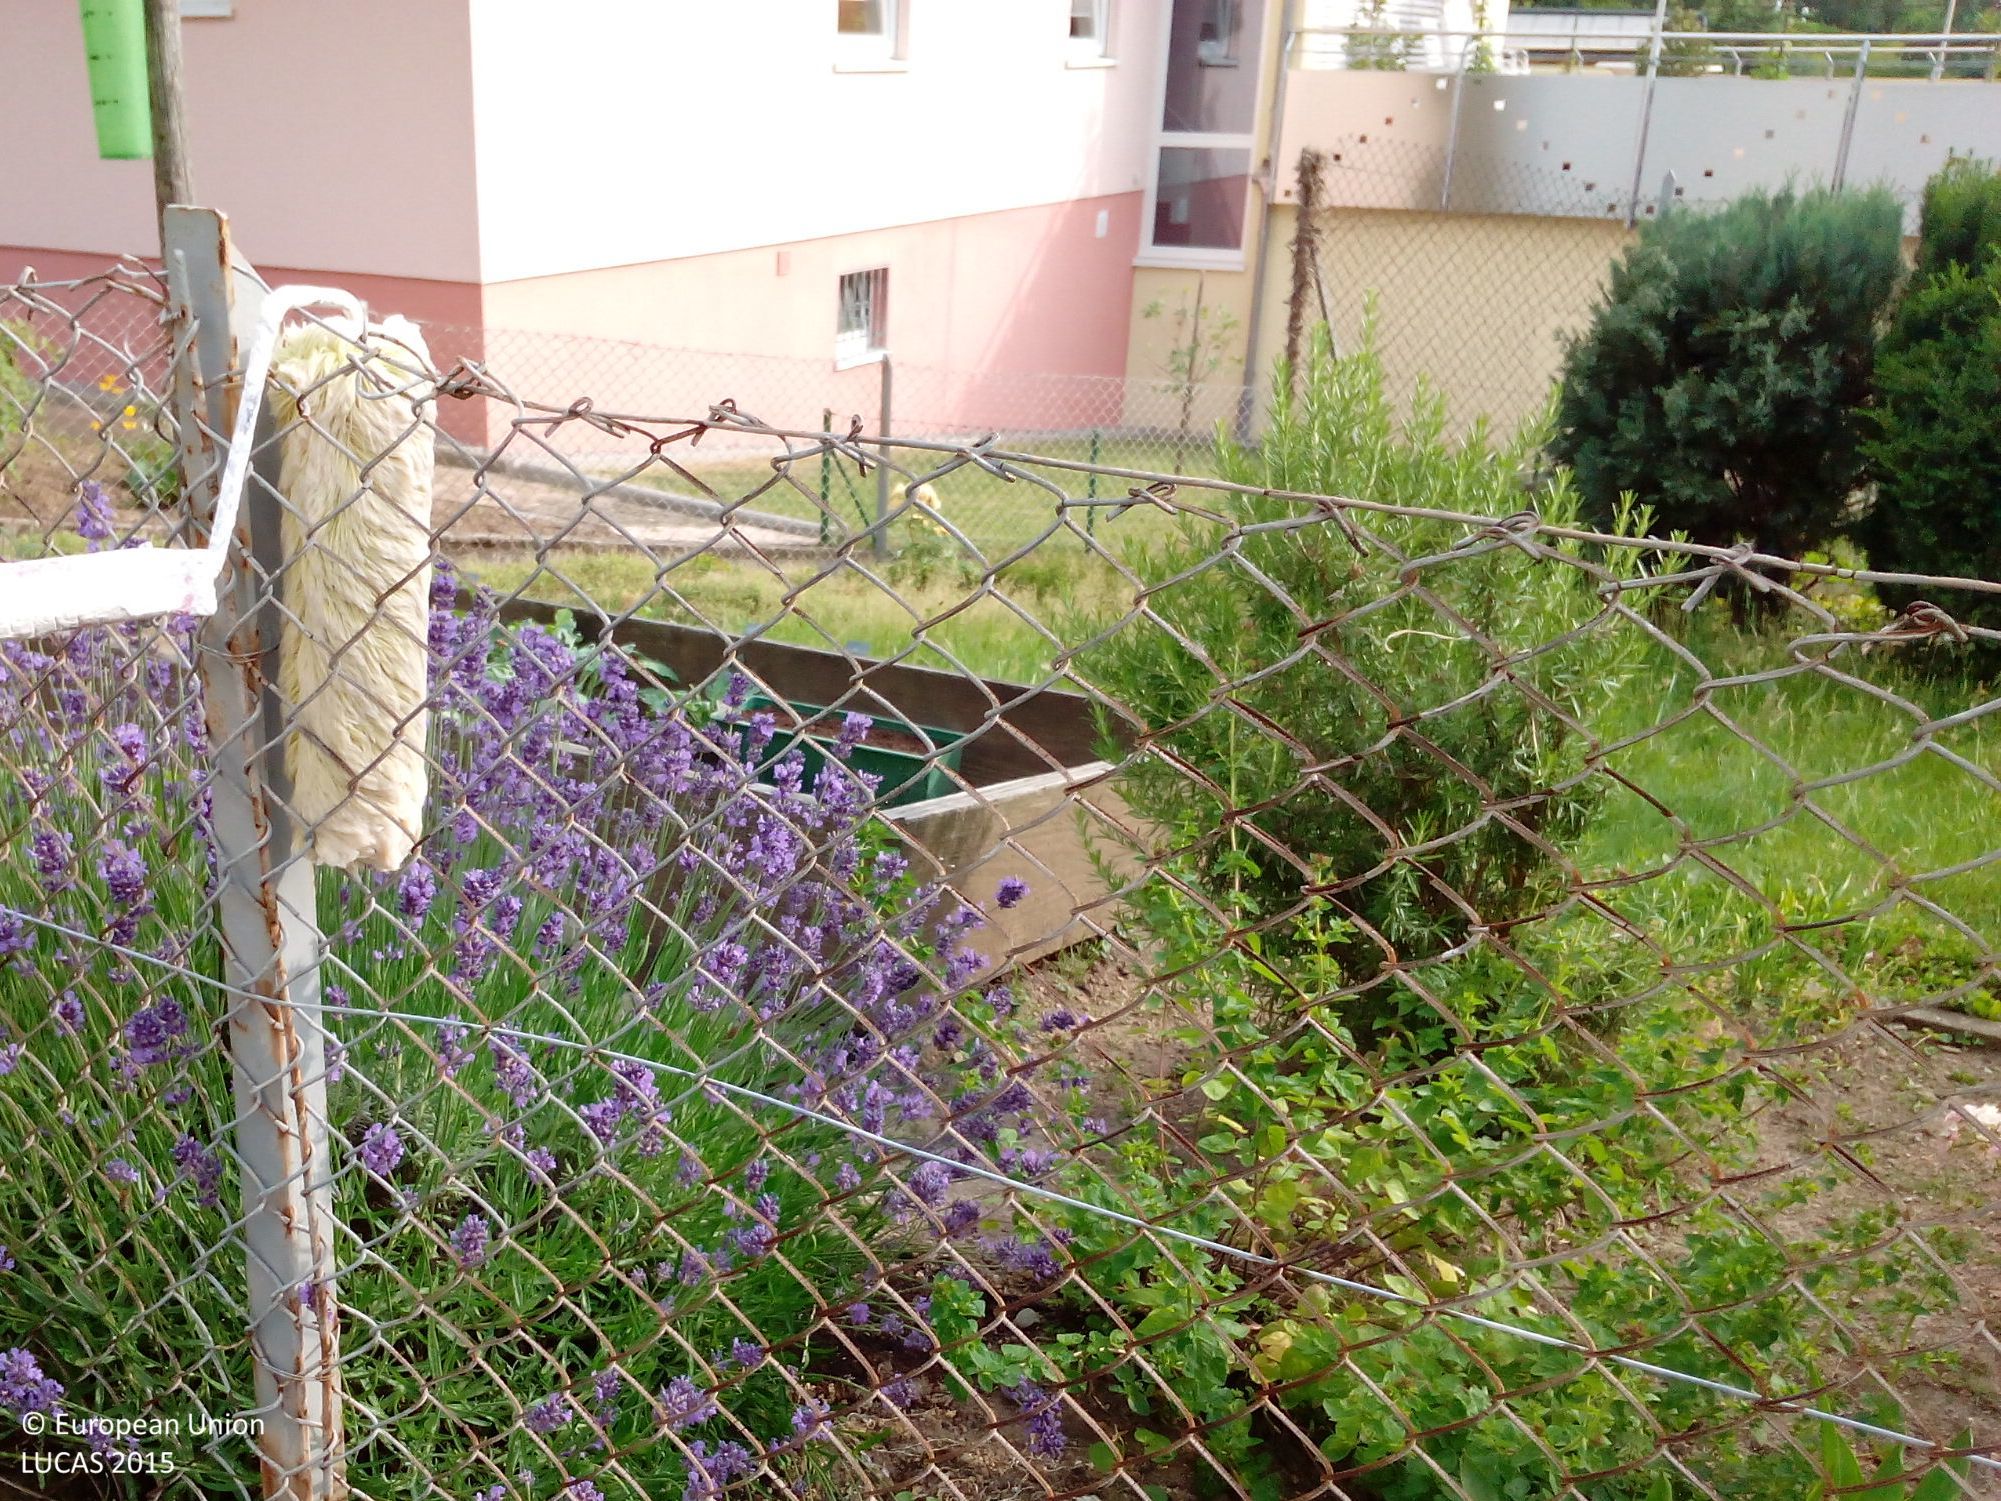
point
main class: Grassland
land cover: Grassland without tree/shrub cover
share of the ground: > 75 %
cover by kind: herbaceous plants 100 %
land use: Residential
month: June
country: DE
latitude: 48.7122
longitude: 8.1660
